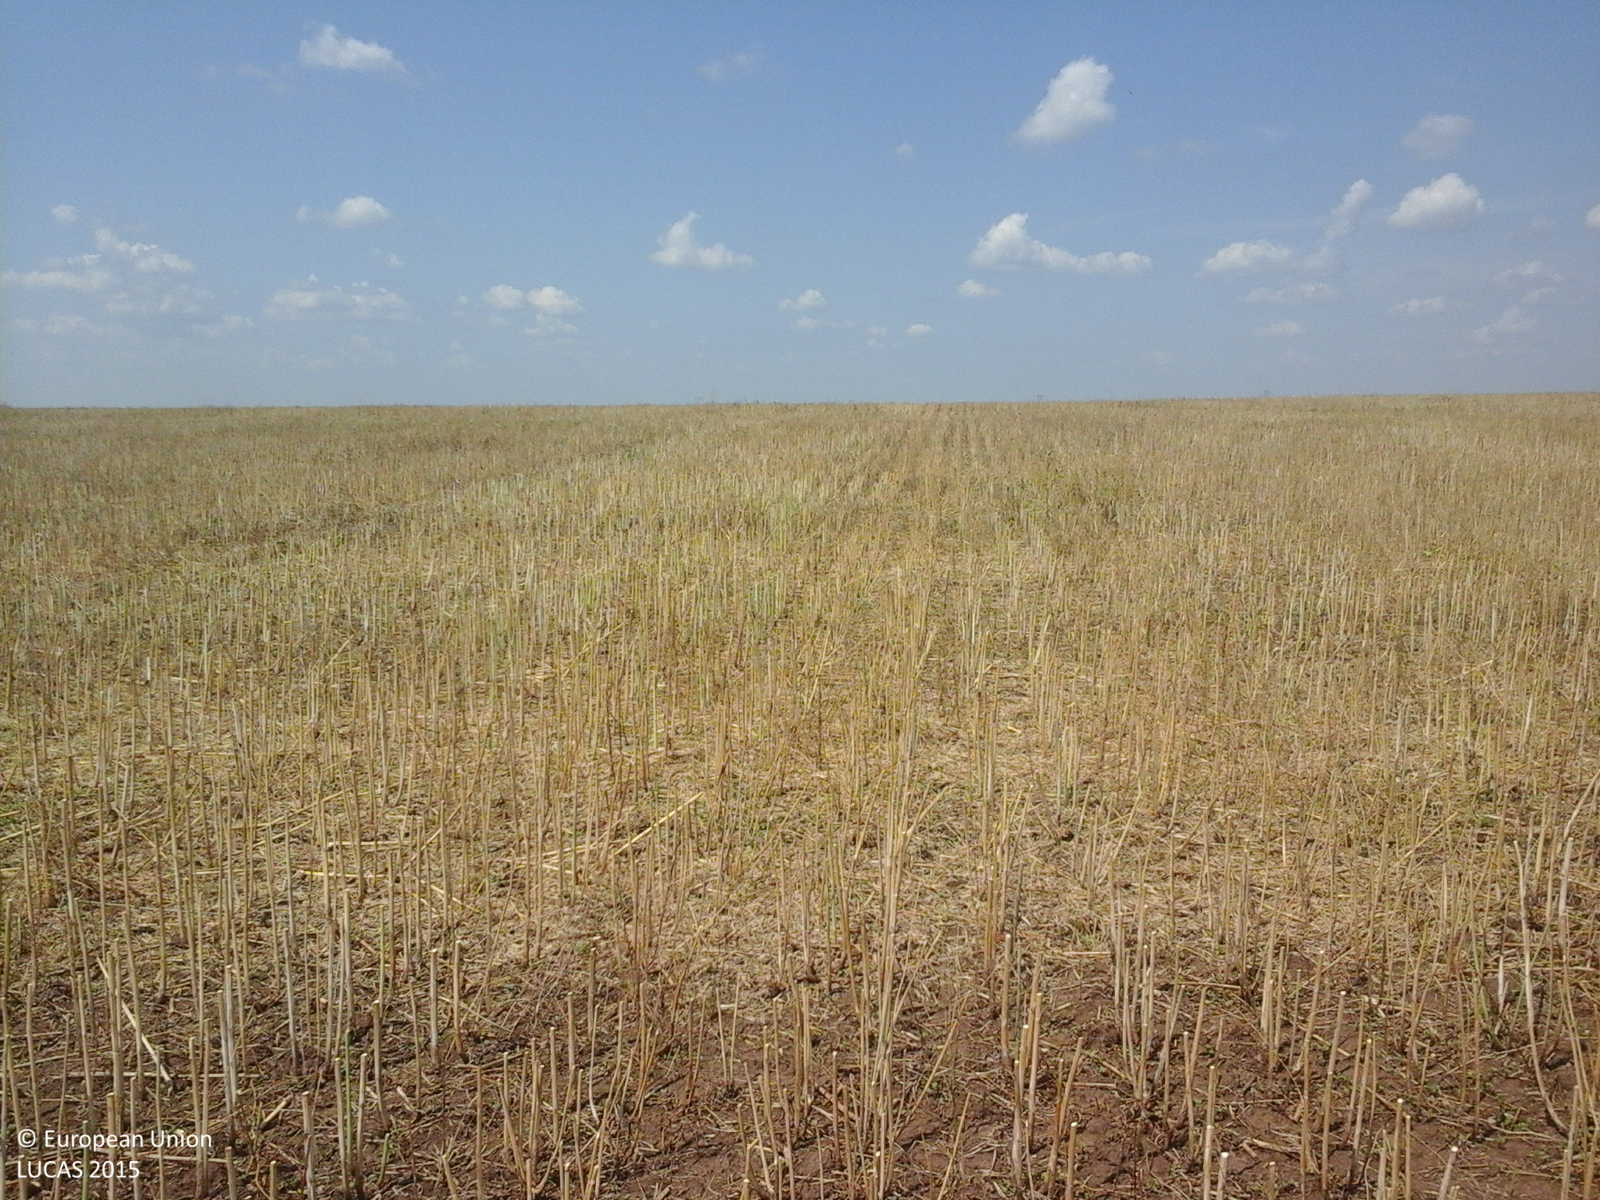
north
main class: Cropland
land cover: Rape and turnip rape
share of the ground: < 10 %
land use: Agriculture (excluding fallow land and kitchen gardens)
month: July
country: RO
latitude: 44.0380
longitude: 24.2507
